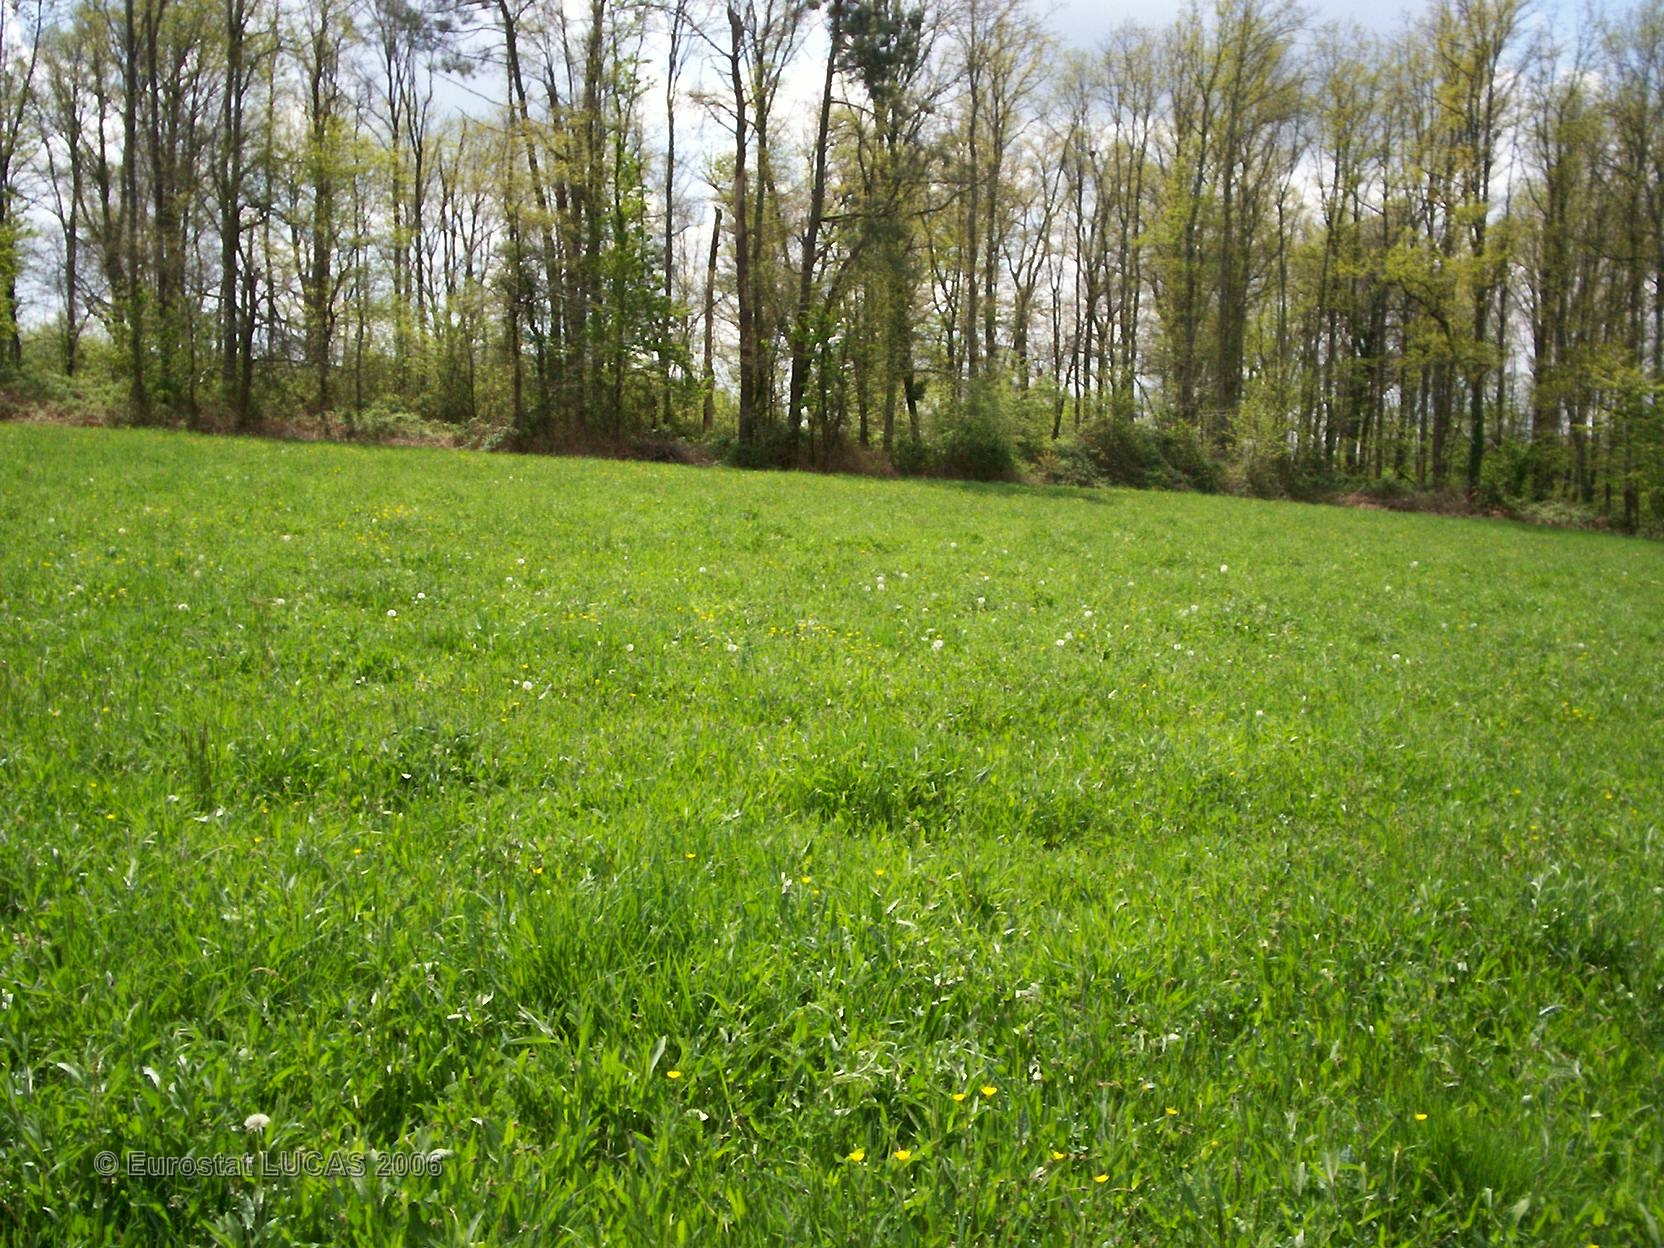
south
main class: Grassland
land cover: Grassland without tree/shrub cover
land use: Agriculture (excluding fallow land and kitchen gardens)
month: April
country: FR
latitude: 45.6448
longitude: 0.5822
